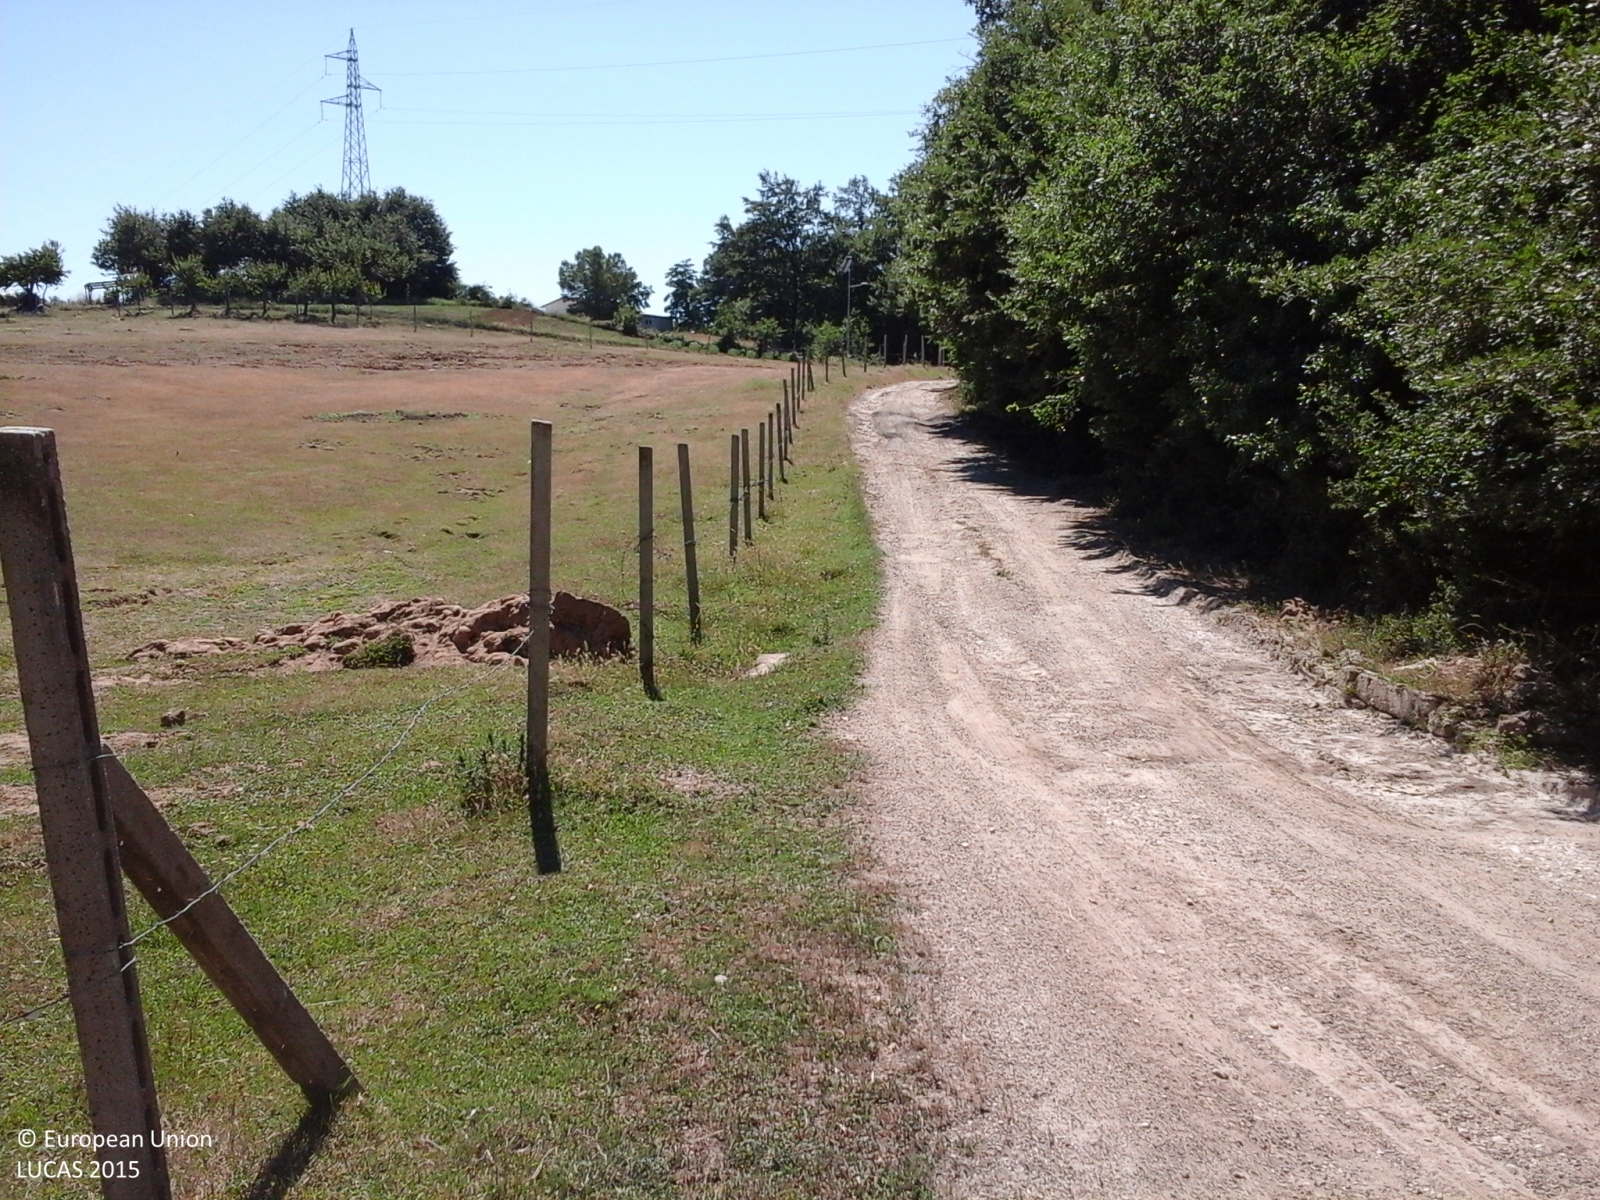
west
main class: Woodland
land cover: Broadleaved woodland
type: thermophilous deciduous forest
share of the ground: > 75 %
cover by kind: broadleaved forest trees 100 %
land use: Forestry
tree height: > 5 m
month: July
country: IT
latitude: 41.6570
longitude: 14.7273
